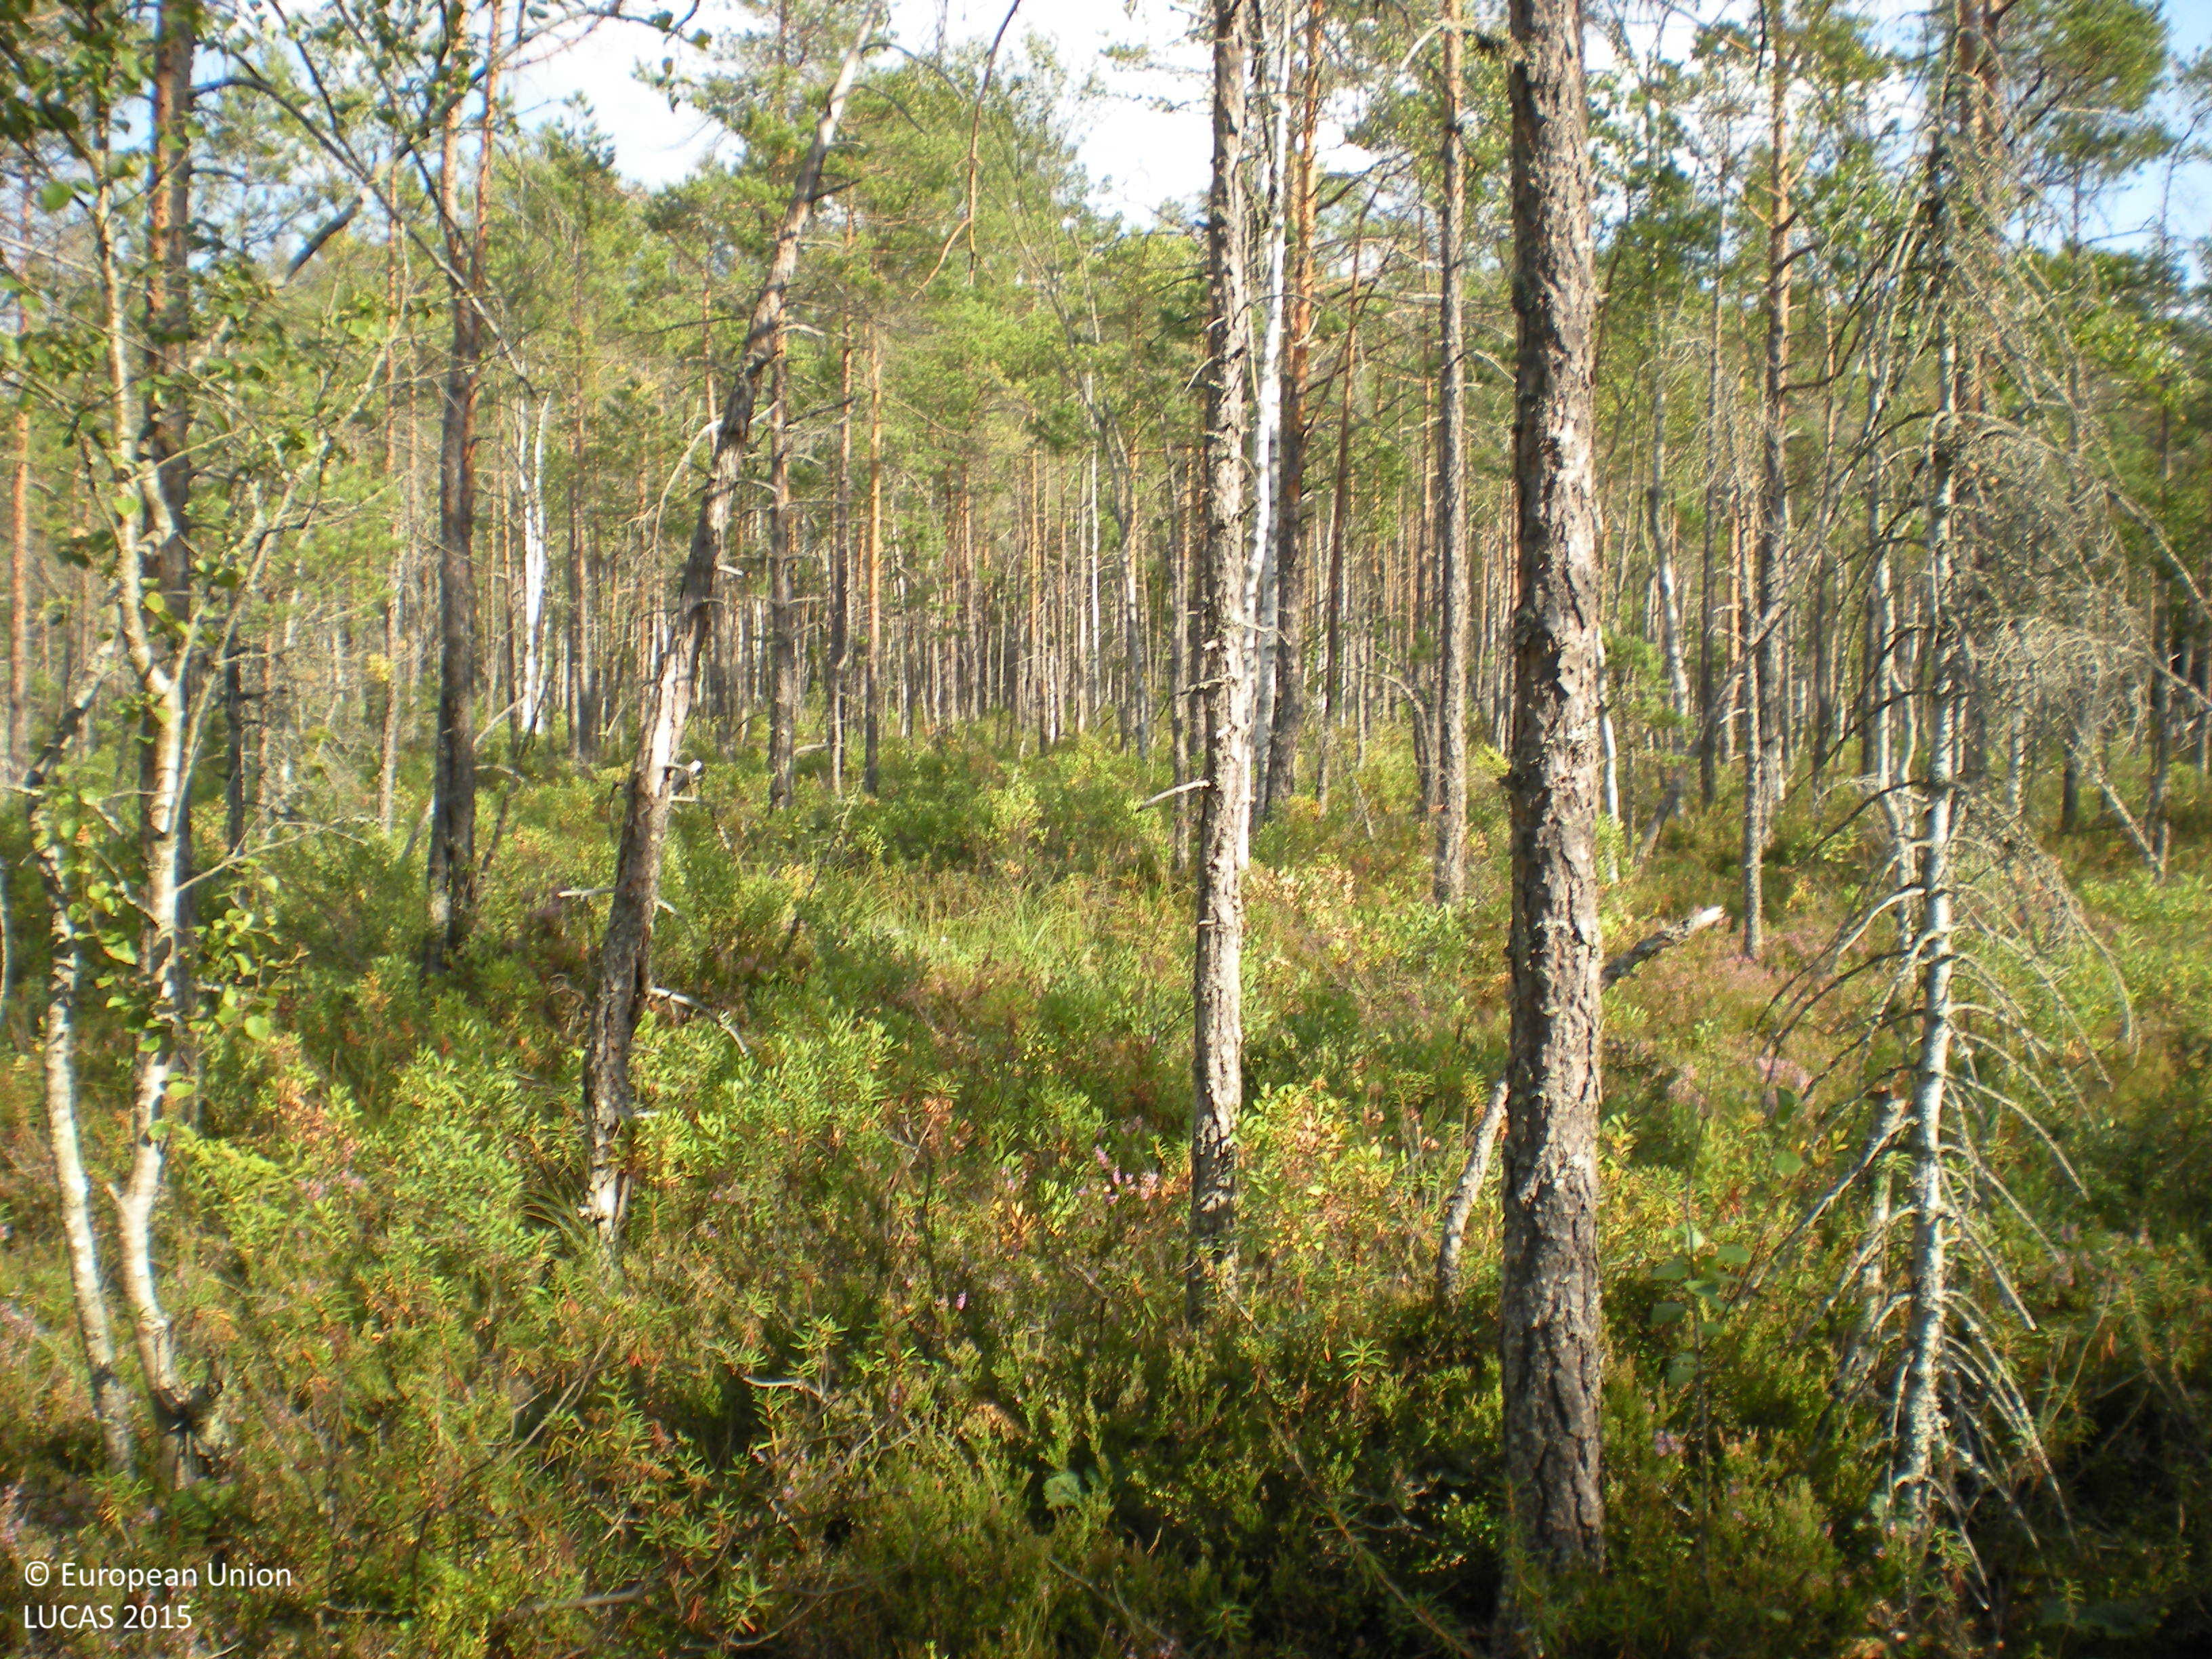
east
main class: Woodland
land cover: Pine dominated mixed woodland
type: boreal forest
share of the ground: 50 - 75 %
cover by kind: coniferous forest trees 45 %, shrubs 30 %, broadleaved forest trees 15 %, herbaceous plants 5 %, lichens and mosses 5 %
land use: Forestry
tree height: < 5 m
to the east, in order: Pine dominated mixed woodland; Other mixed woodland; Shrubland with sparse tree cover; Grassland with sparse tree/shrub cover; Other coniferous woodland; Pine dominated mixed woodland
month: August
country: SE
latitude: 60.4003
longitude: 17.0867
